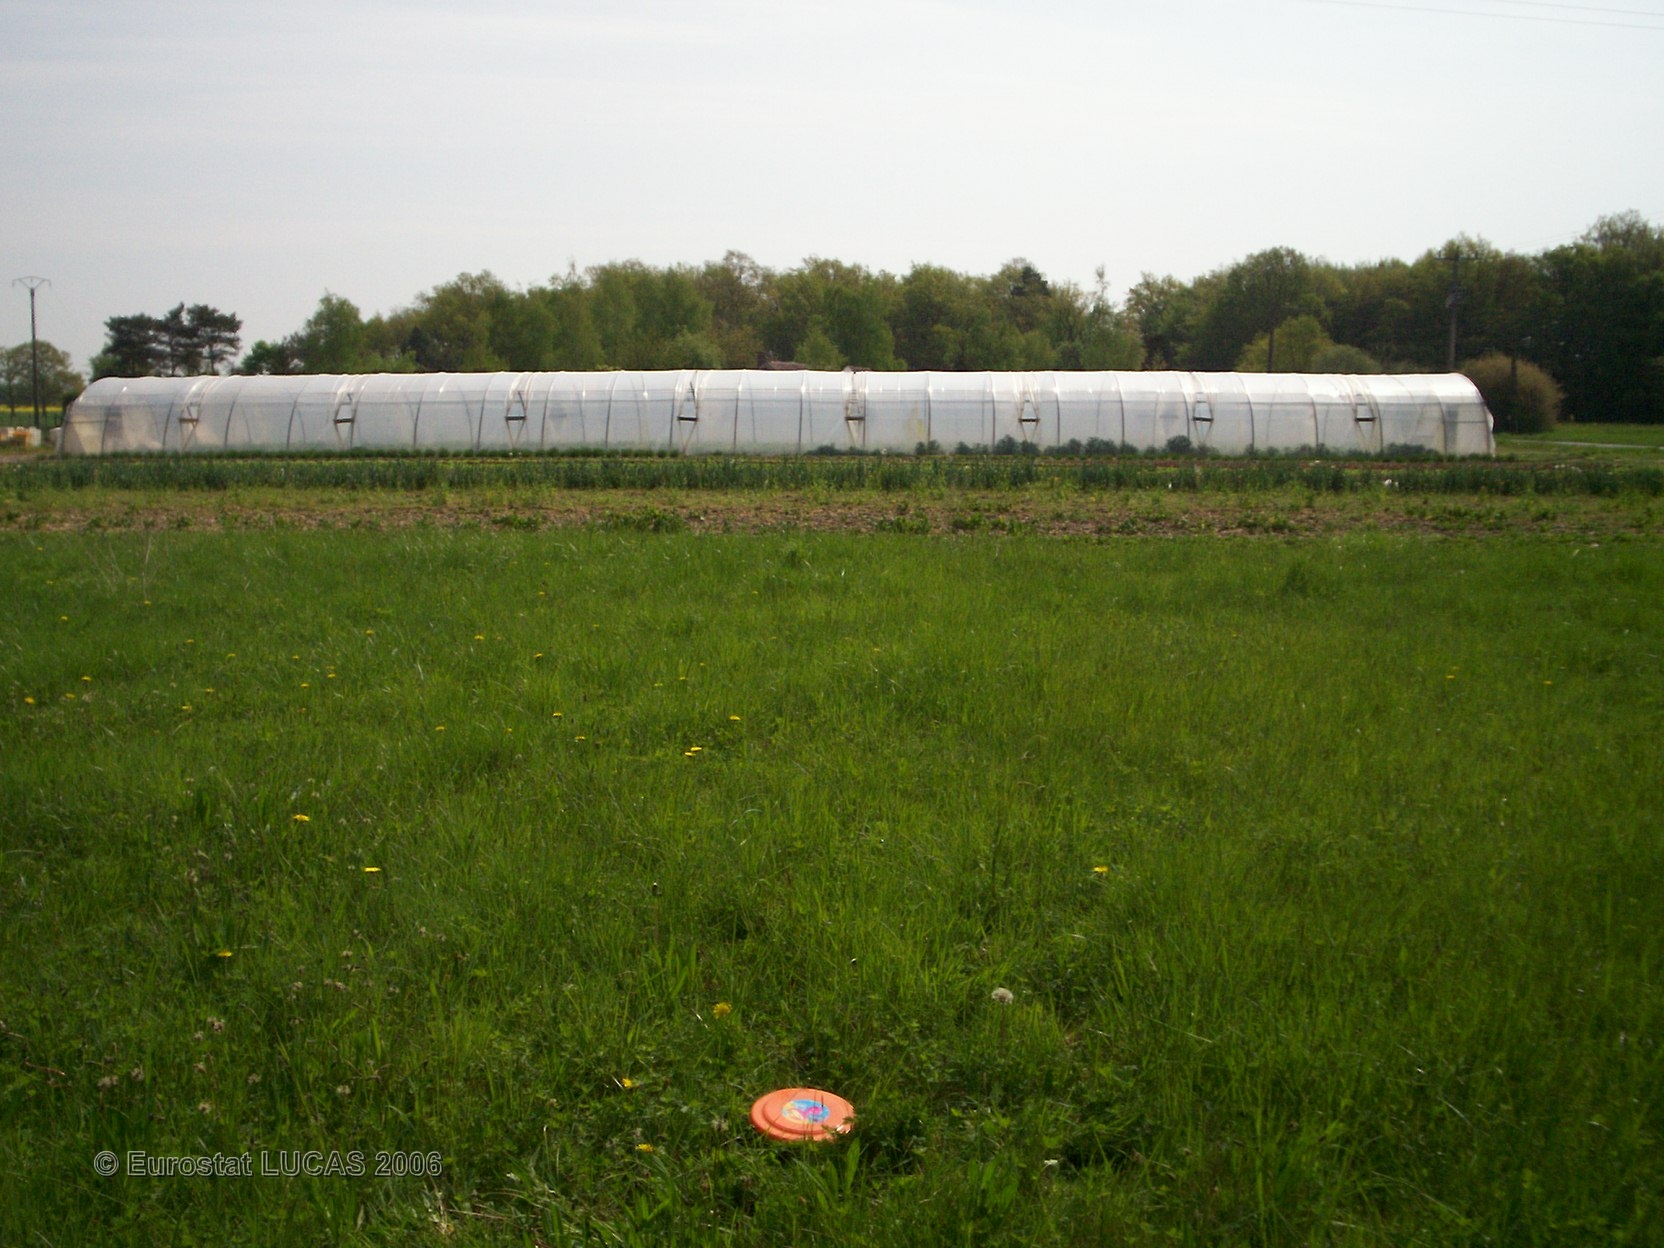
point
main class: Grassland
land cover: Grassland with sparse tree/shrub cover
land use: Agriculture (excluding fallow land and kitchen gardens)
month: May
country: FR
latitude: 48.0894
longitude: 2.9709
